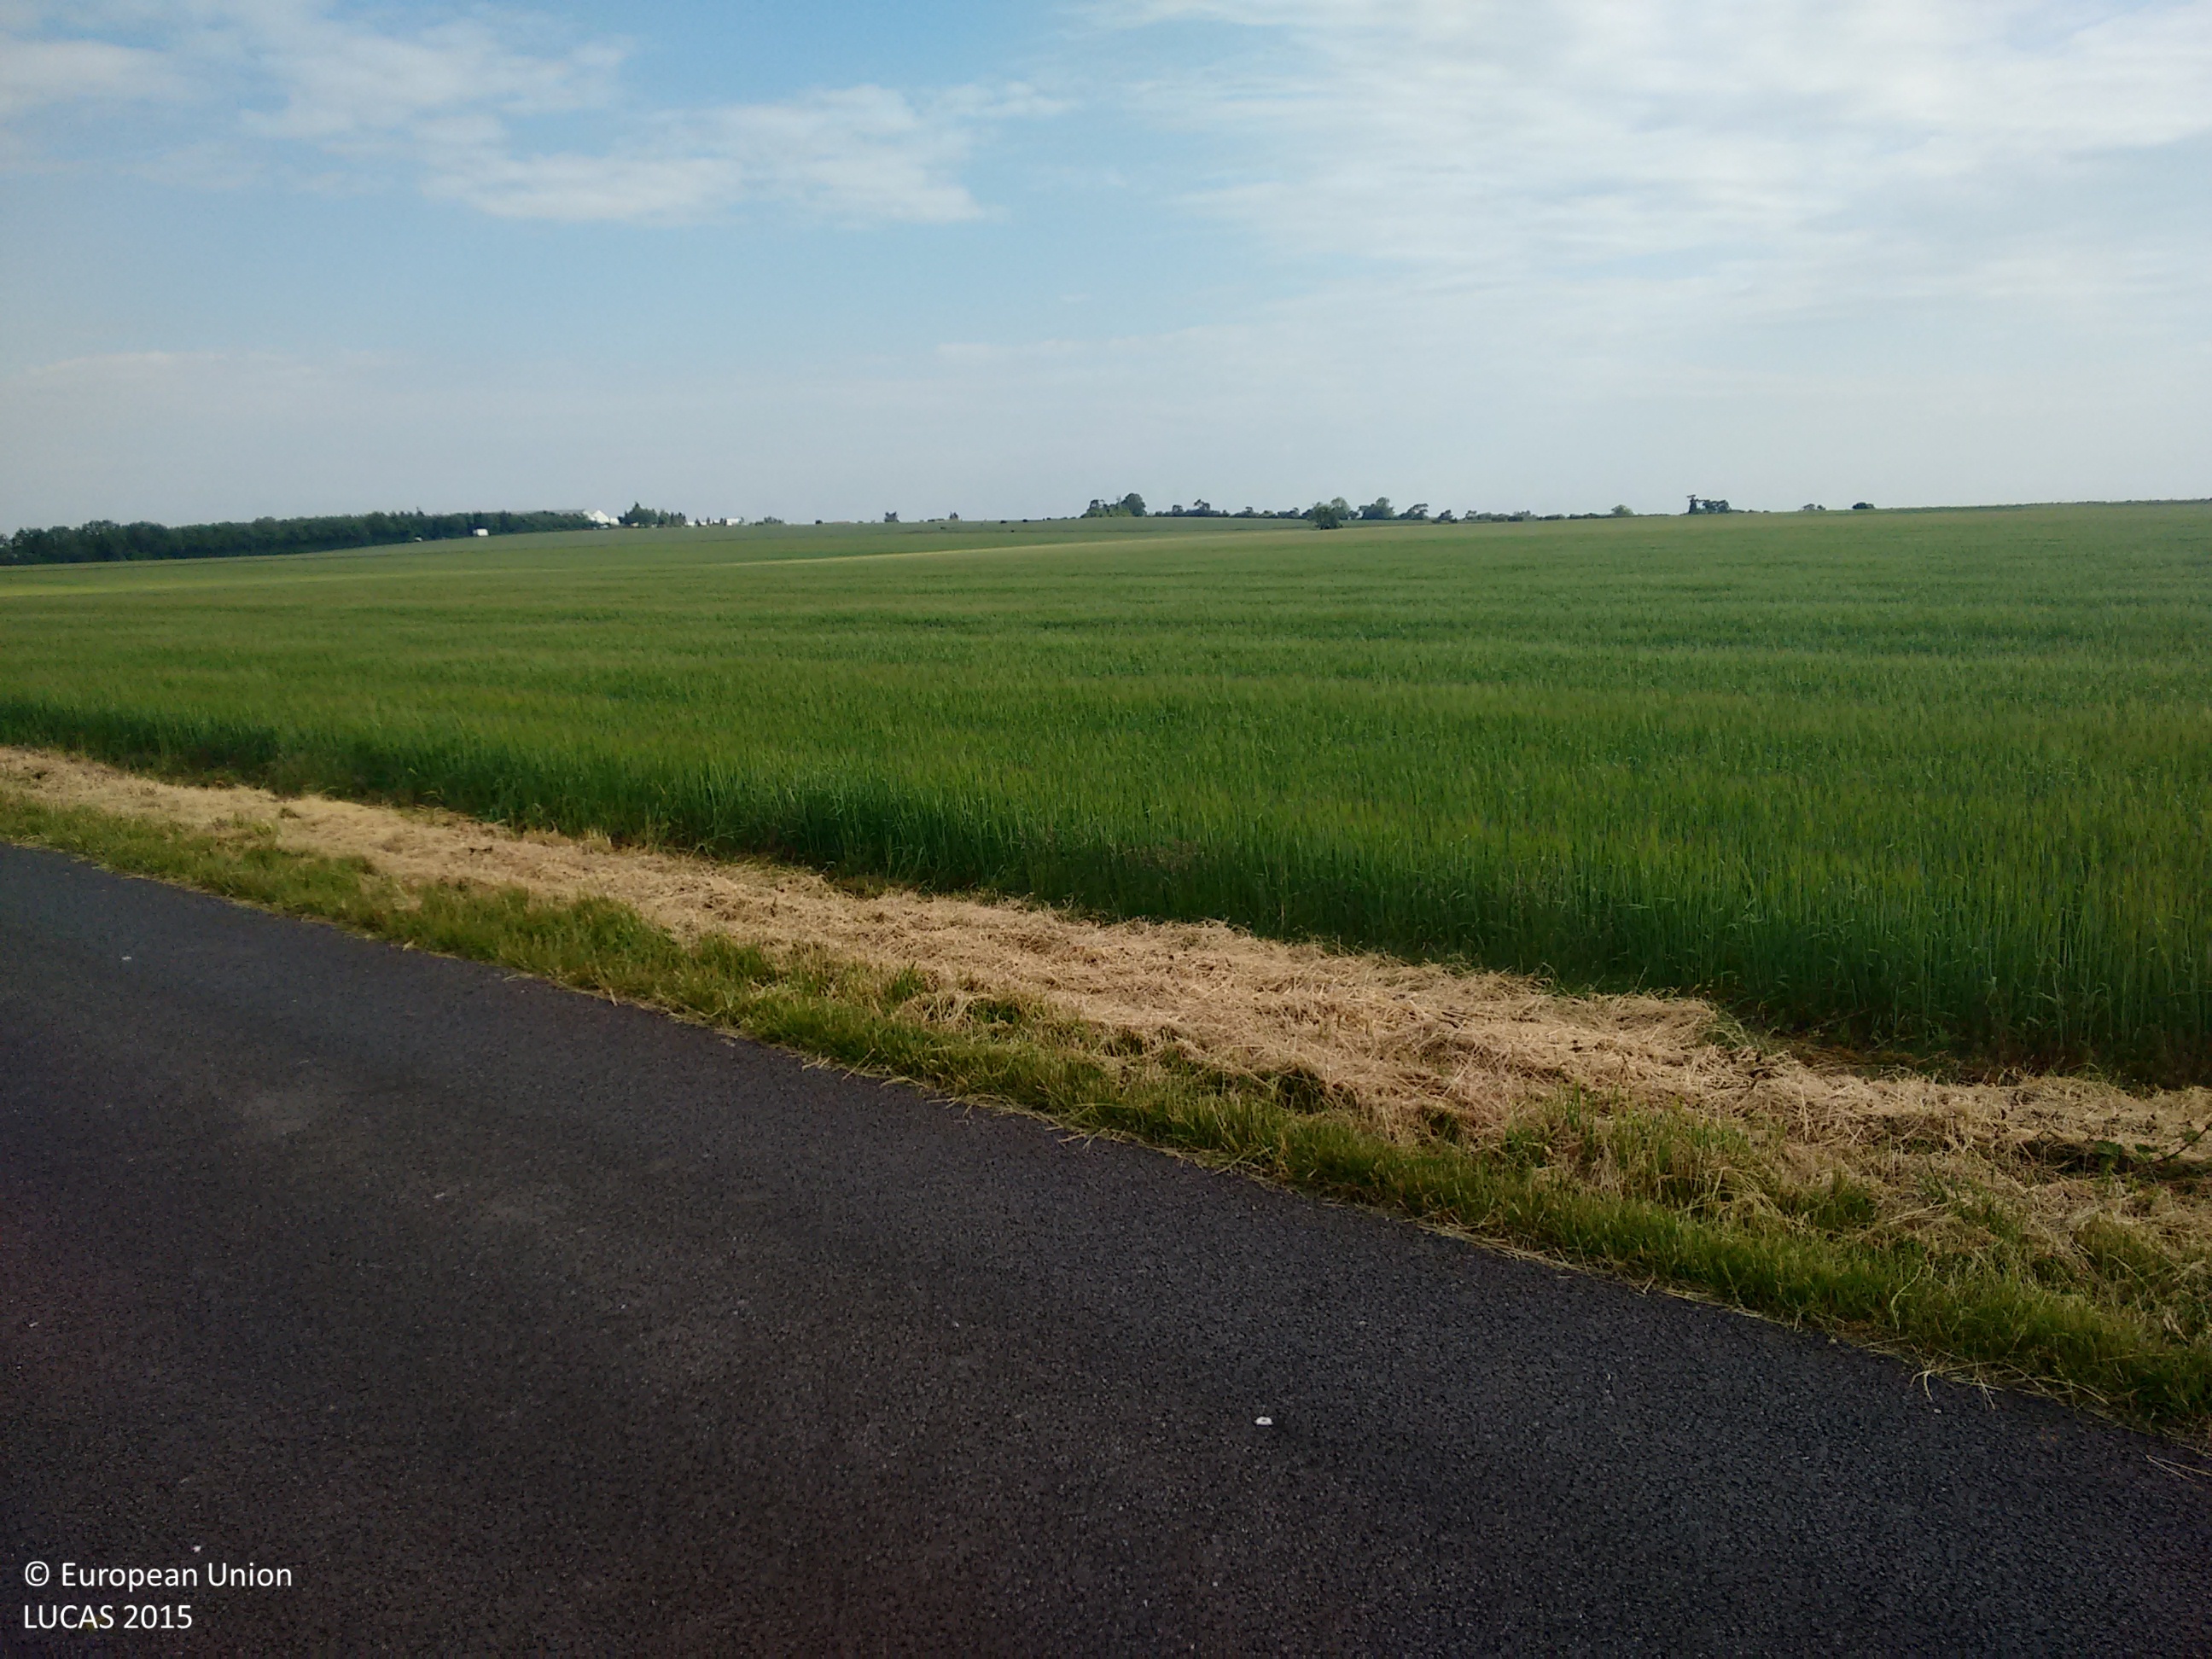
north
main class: Cropland
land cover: Barley
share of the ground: > 75 %
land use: Agriculture (excluding fallow land and kitchen gardens)
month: June
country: GB
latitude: 51.1157
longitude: -1.7834
